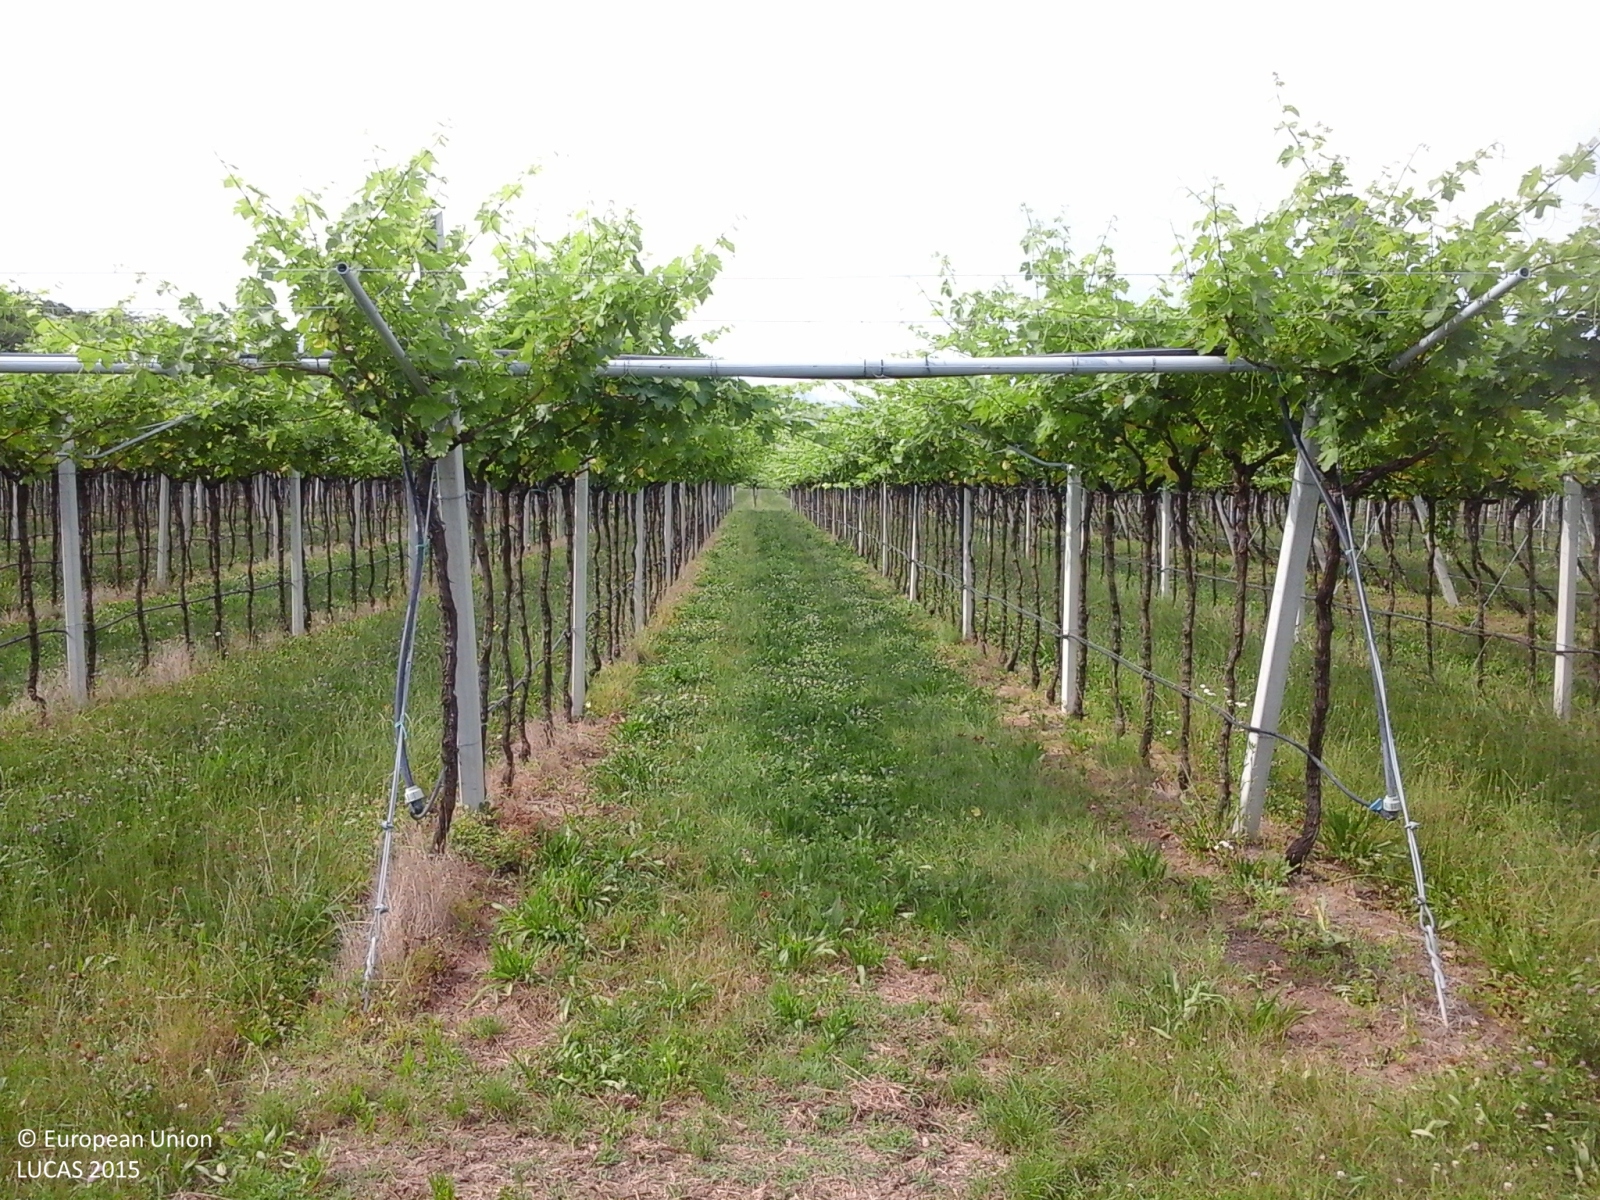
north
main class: Cropland
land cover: Potatoes
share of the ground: > 75 %
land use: Agriculture (excluding fallow land and kitchen gardens)
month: June
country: IT
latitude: 45.5005
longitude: 10.9071
